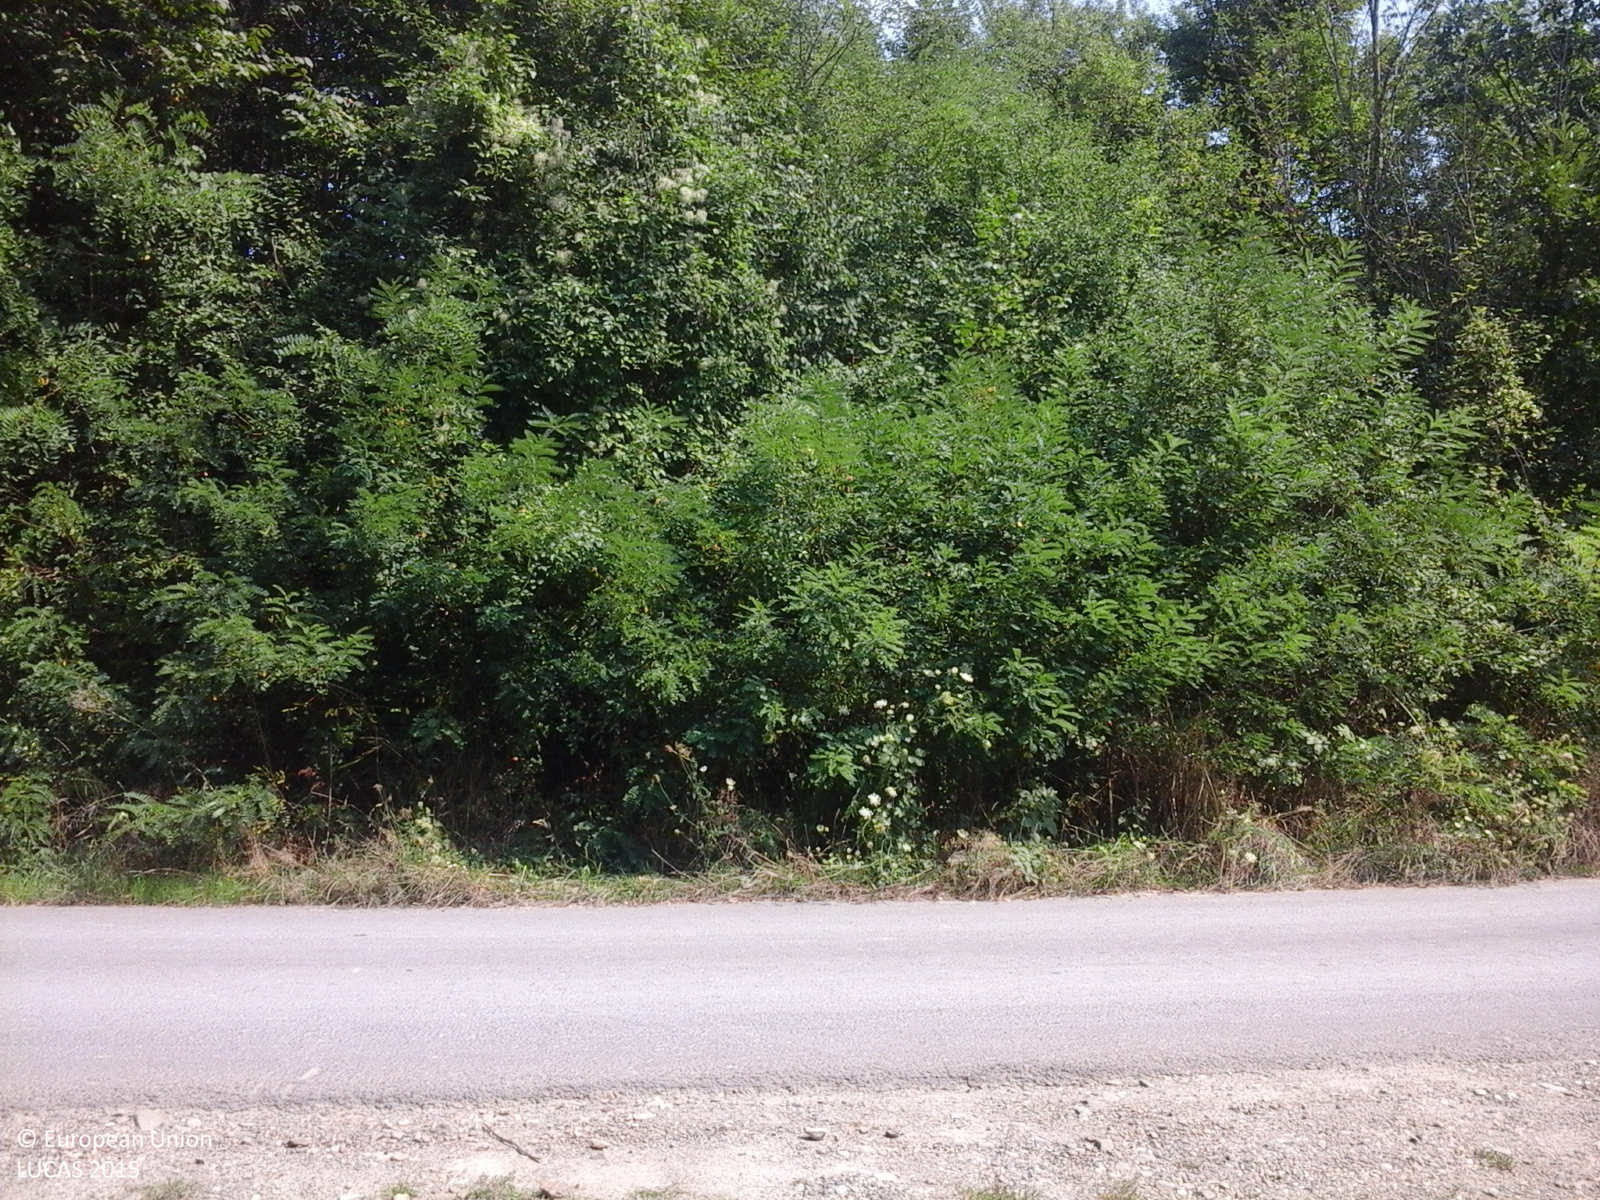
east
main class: Woodland
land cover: Broadleaved woodland
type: acidophilous oak and oak-birch forest
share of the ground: > 75 %
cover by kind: broadleaved forest trees 100 %
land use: Forestry
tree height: > 5 m
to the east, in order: Broadleaved woodland
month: August
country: RO
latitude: 46.2772
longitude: 22.4427
